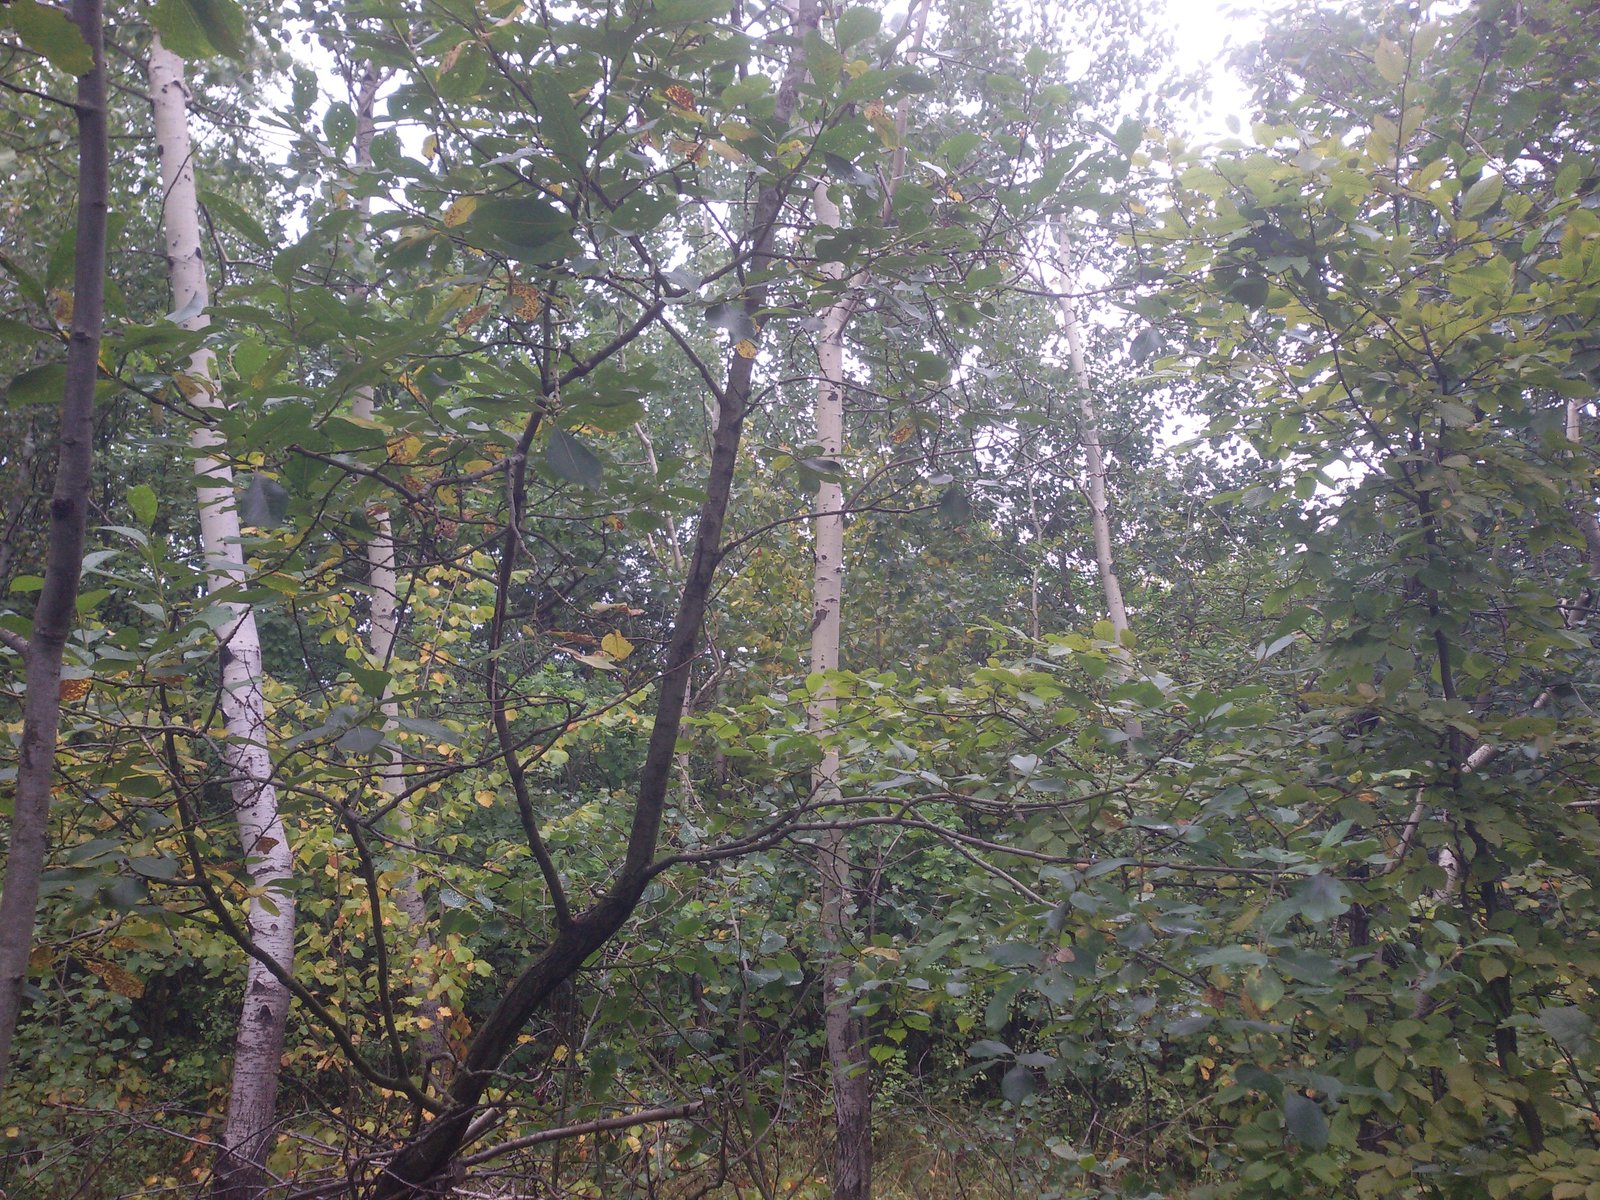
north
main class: Woodland
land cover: Broadleaved woodland
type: mesophytic deciduous forest
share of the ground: > 75 %
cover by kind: broadleaved forest trees 75 %, herbaceous plants 15 %, shrubs 10 %
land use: Forestry
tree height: > 5 m
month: September
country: PL
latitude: 49.6270
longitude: 21.4144
